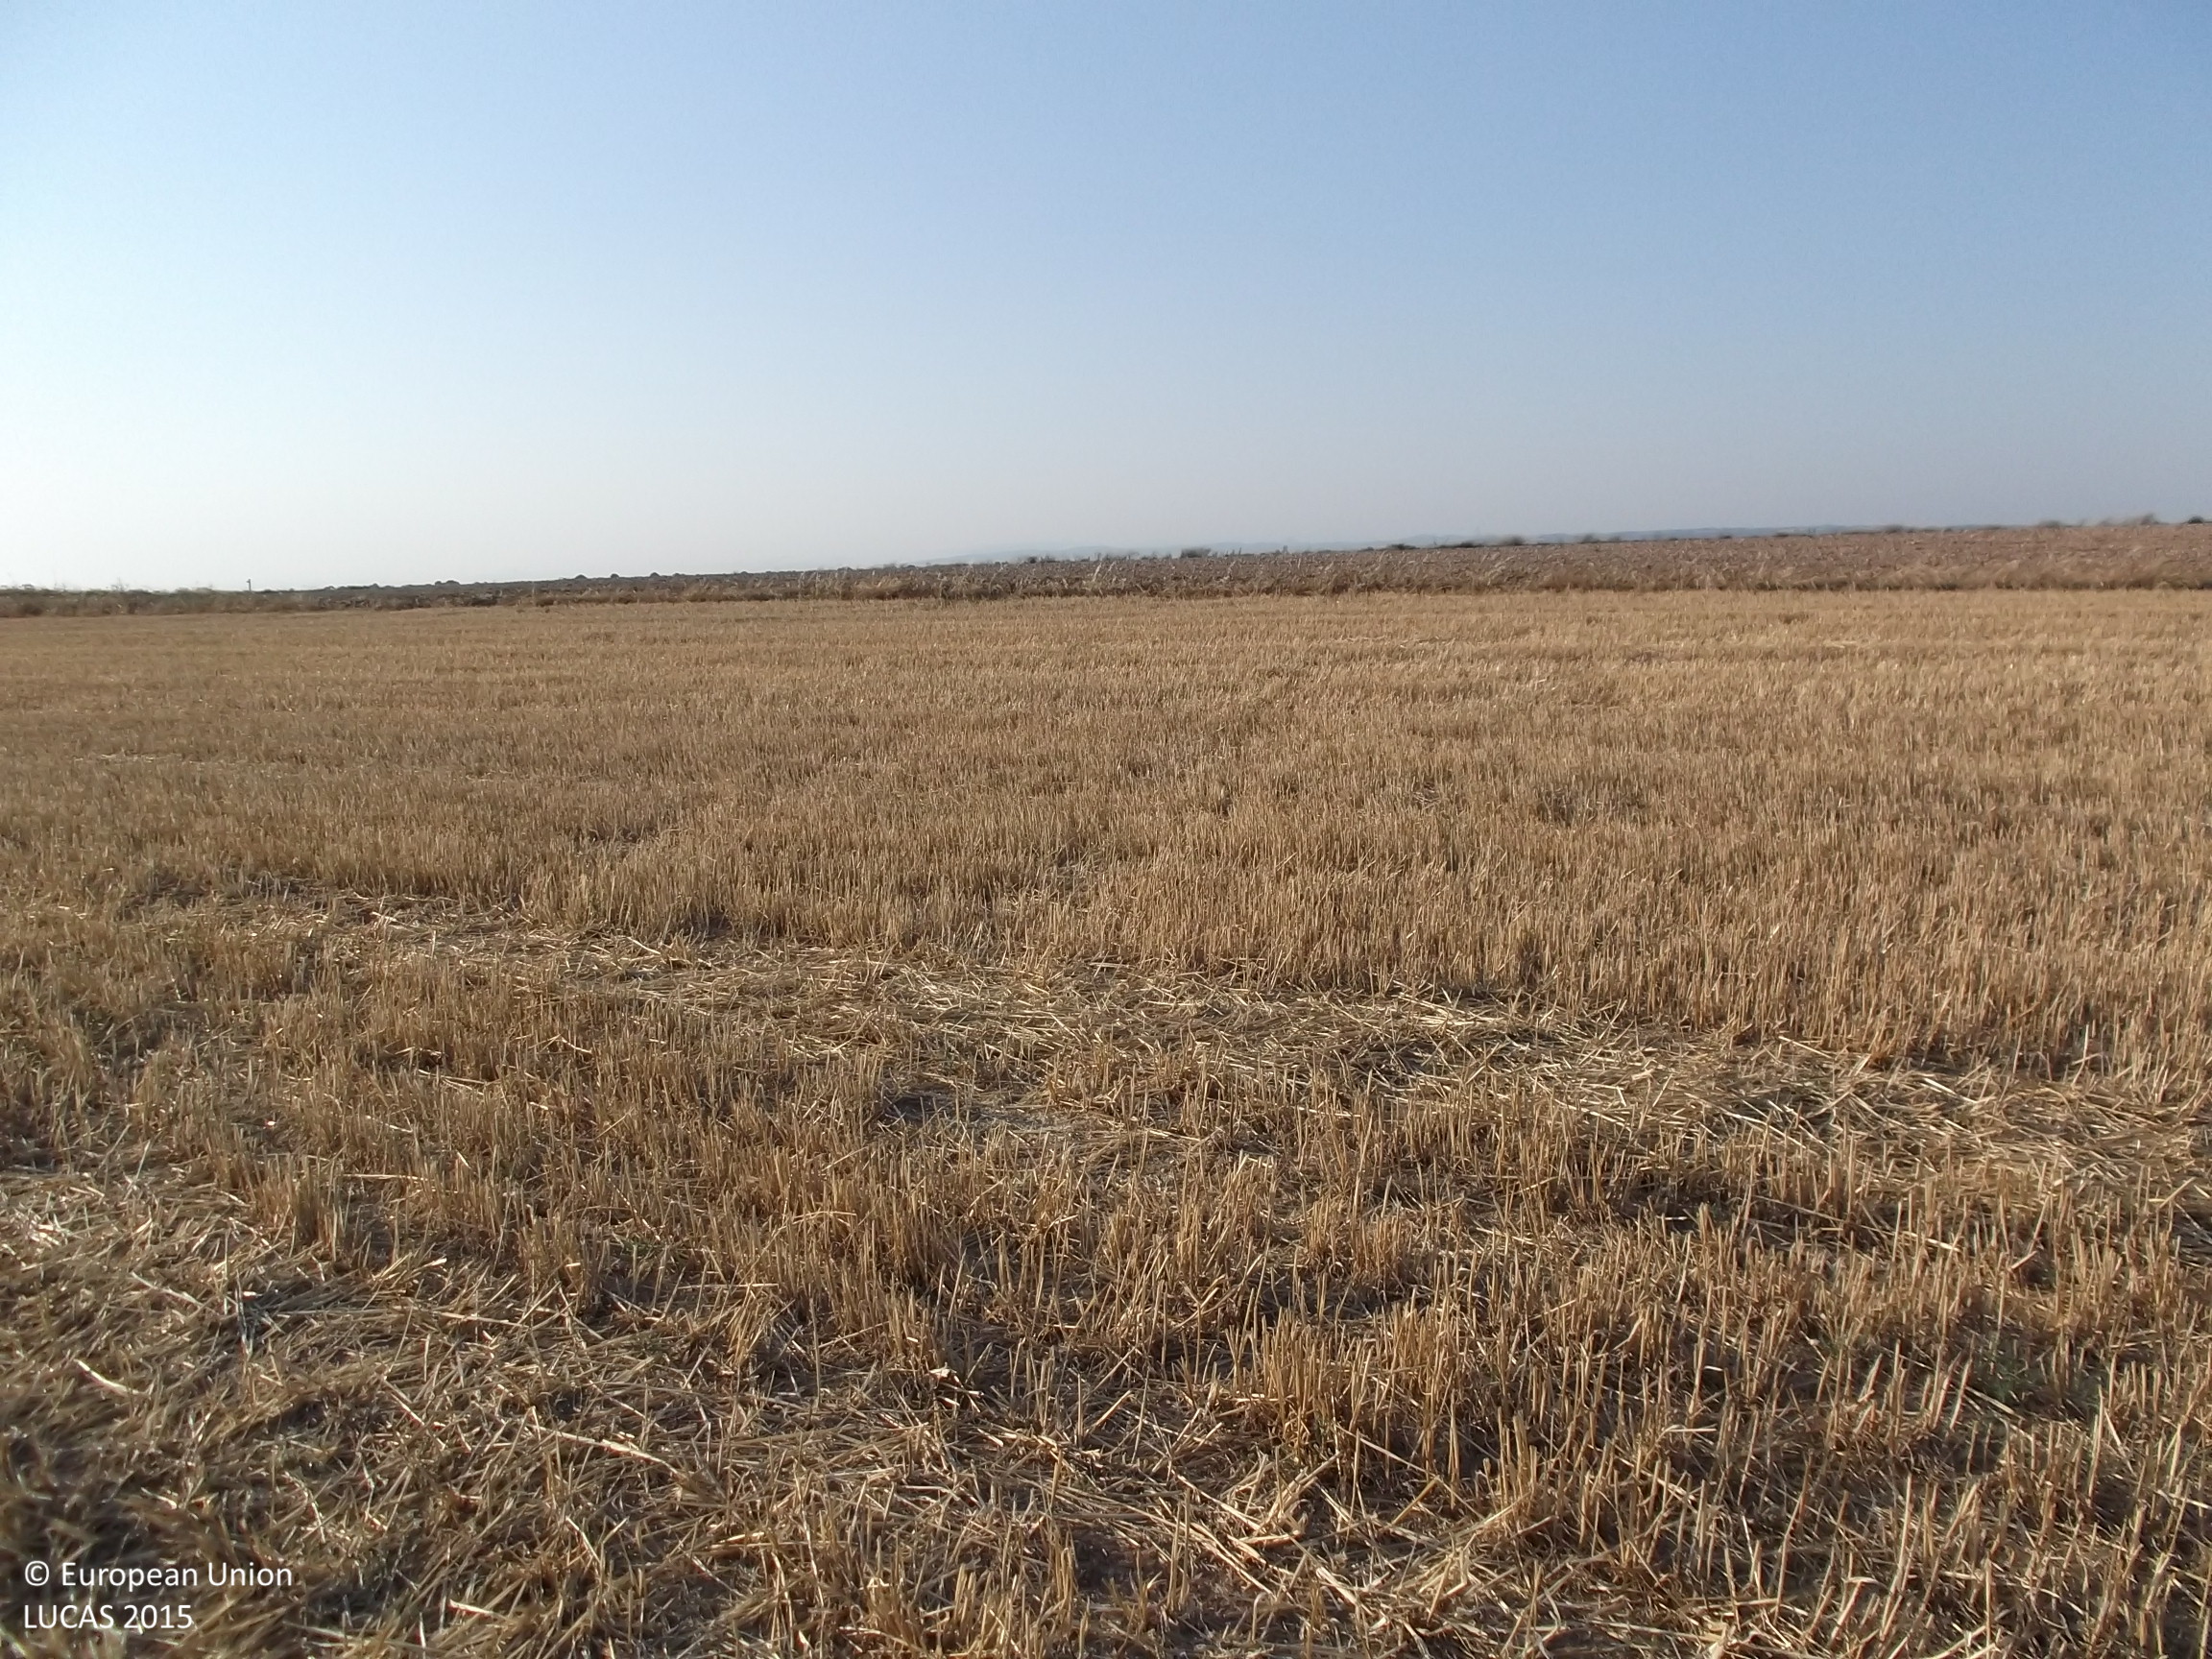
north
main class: Cropland
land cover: Barley
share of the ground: < 10 %
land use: Agriculture (excluding fallow land and kitchen gardens)
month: July
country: ES
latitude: 42.2808
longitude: -1.5656
